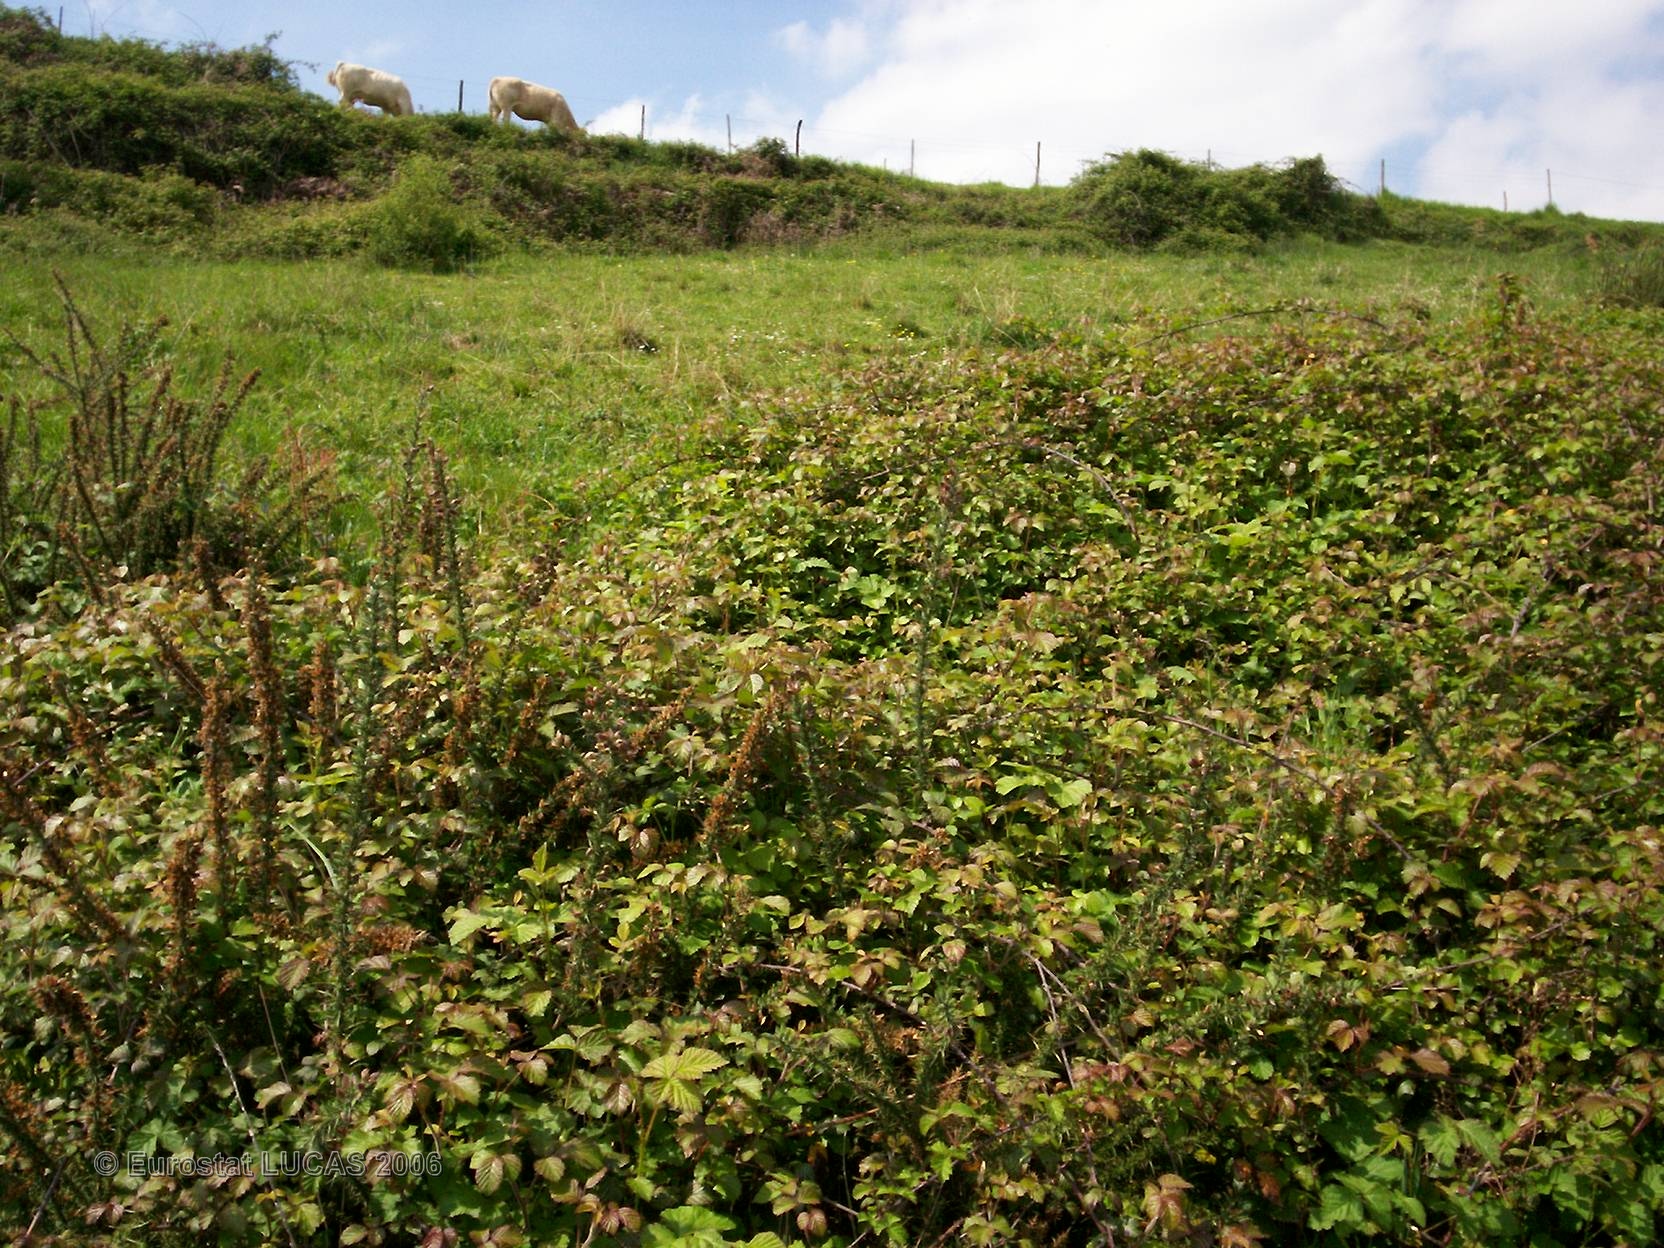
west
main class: Grassland
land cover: Grassland without tree/shrub cover
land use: Agriculture (excluding fallow land and kitchen gardens)
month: April
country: FR
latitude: 43.3305
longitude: -0.6278
